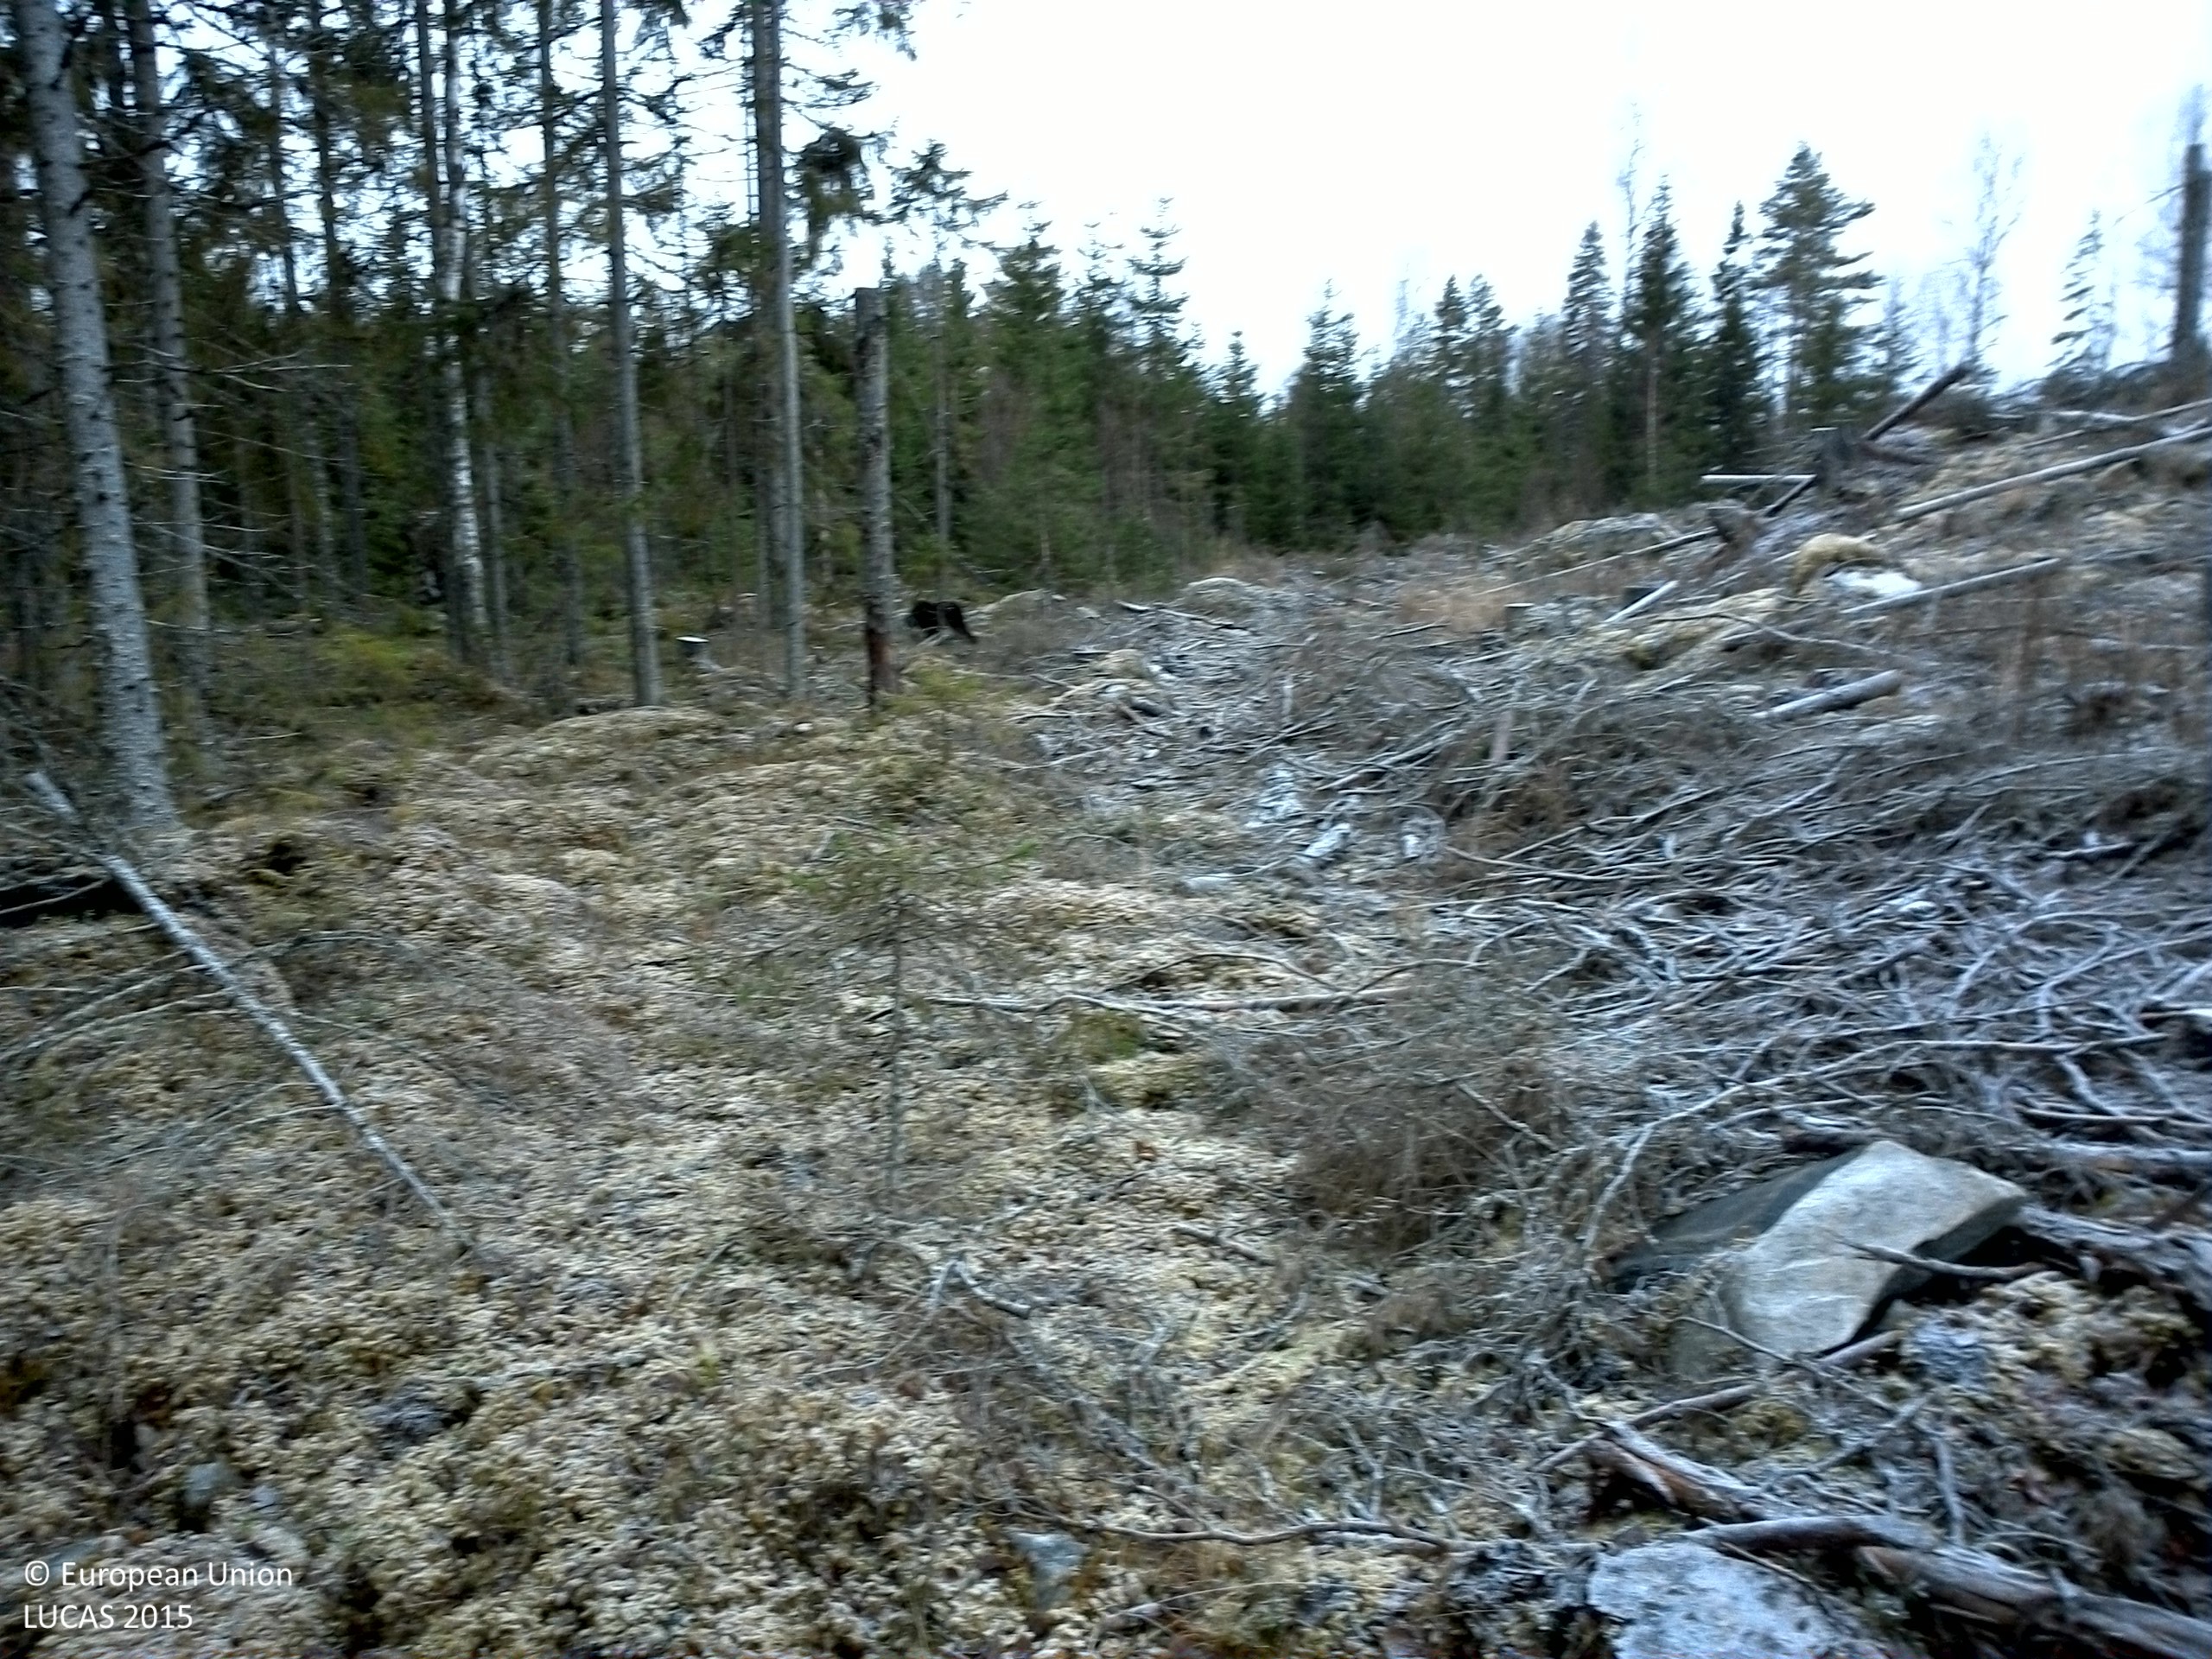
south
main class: Shrubland
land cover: Shrubland without tree cover
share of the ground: 25 - 50 %
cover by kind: shrubs 40 %, consolidated bare surface 30 %, herbaceous plants 15 %, lichens and mosses 15 %
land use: Forestry
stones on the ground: 10 - 25 %
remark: Clear cut
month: November
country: SE
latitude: 60.1393
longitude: 15.6609
